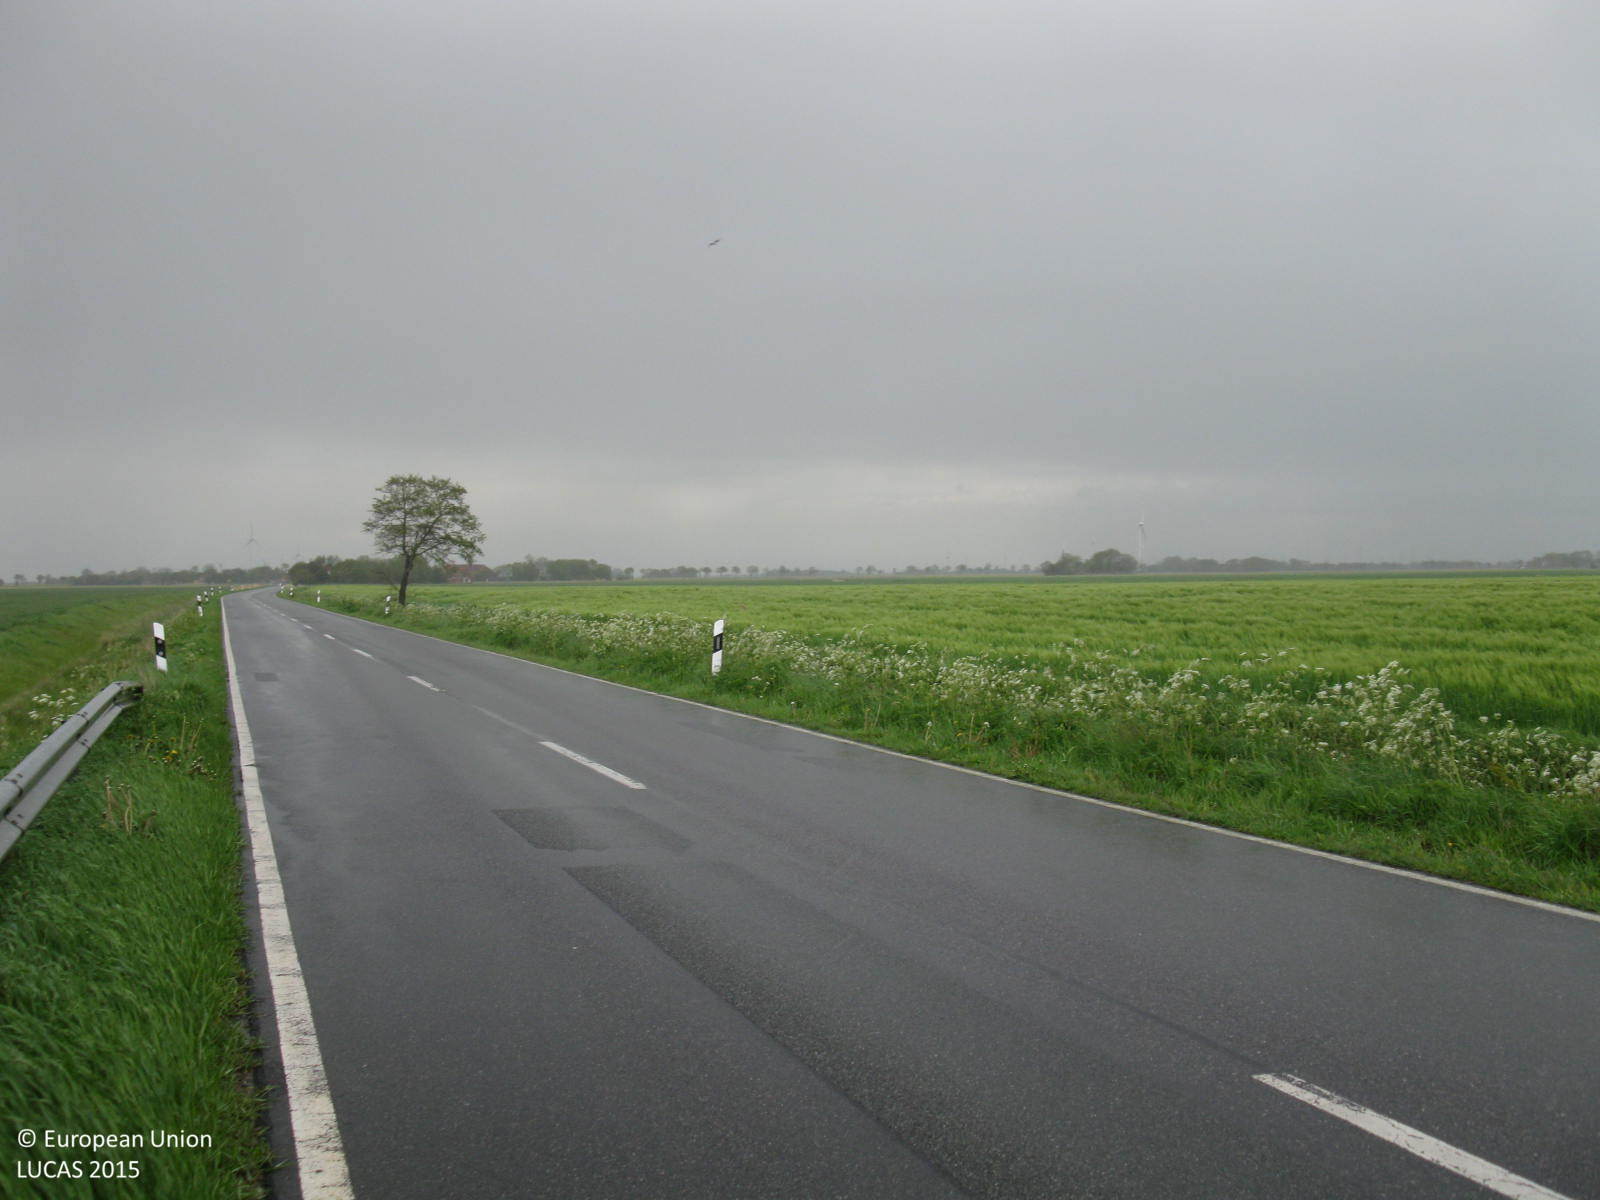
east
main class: Cropland
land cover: Rape and turnip rape
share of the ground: > 75 %
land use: Agriculture (excluding fallow land and kitchen gardens)
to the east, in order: Rape and turnip rape; Grassland without tree/shrub cover; Inland fresh running water
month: May
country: DE
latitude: 53.6587
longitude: 7.2618
